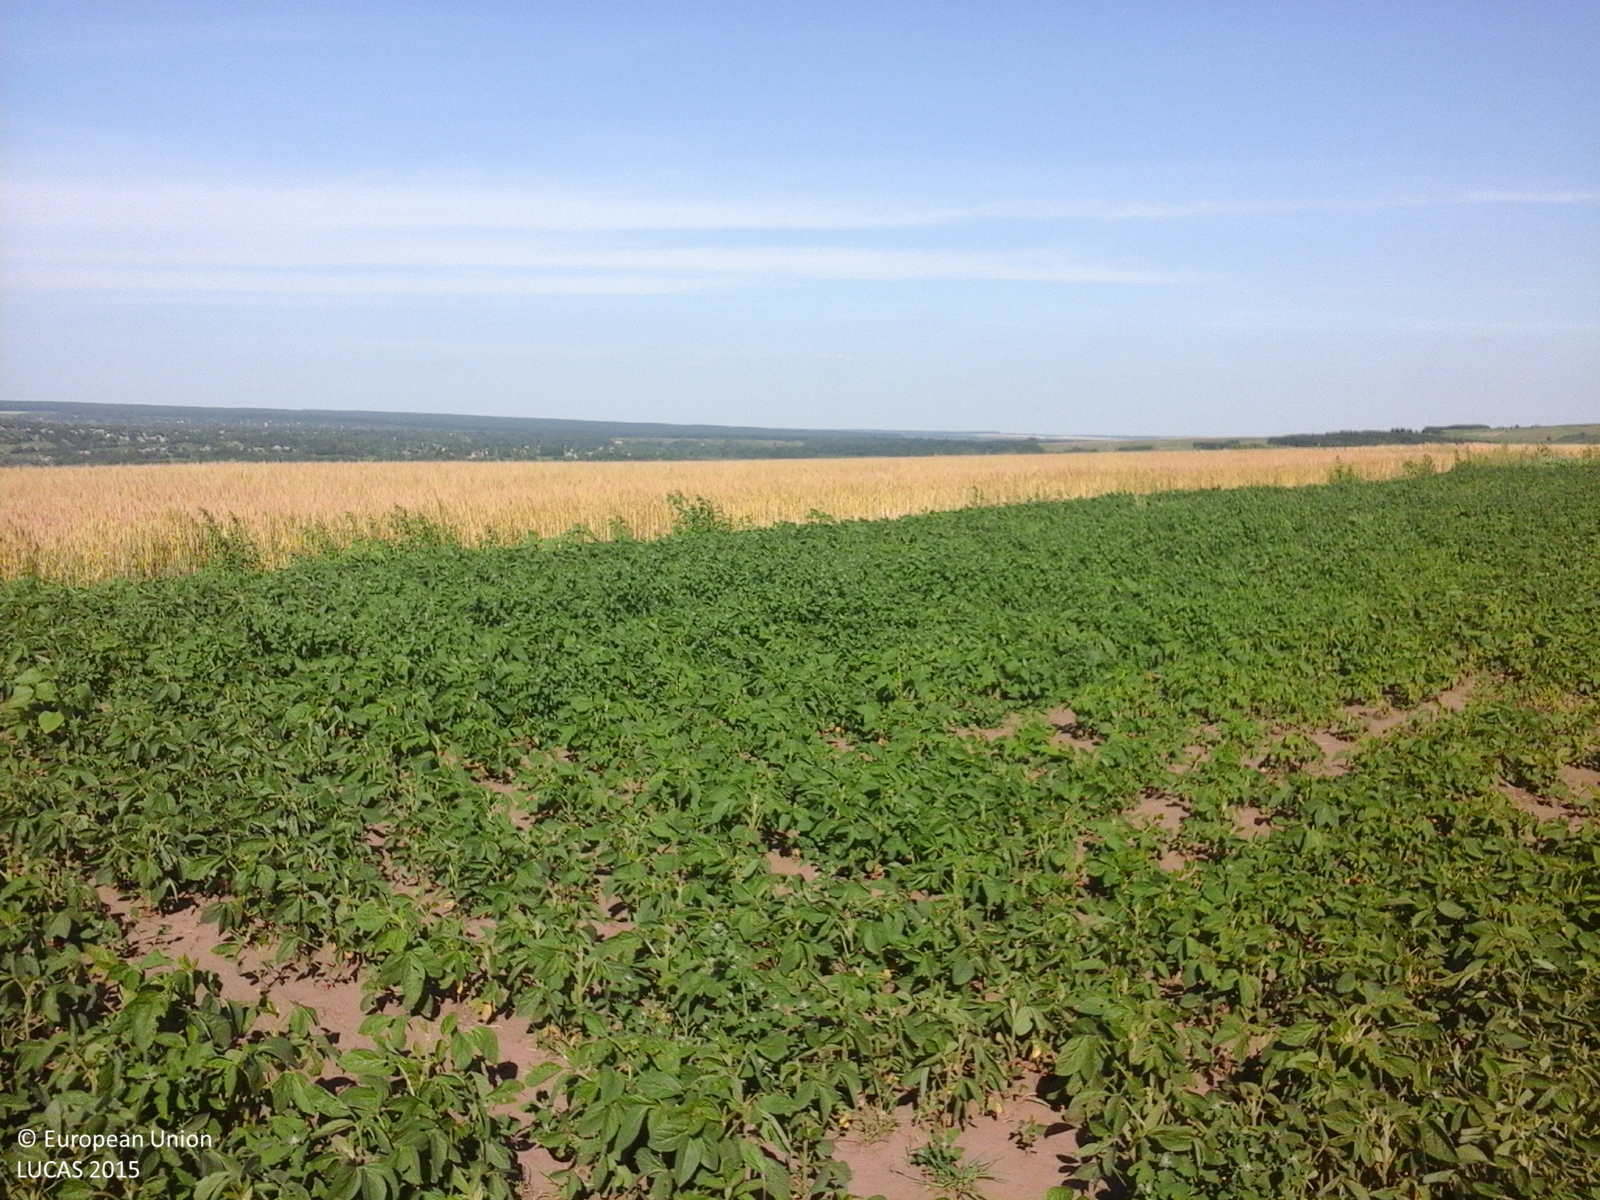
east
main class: Cropland
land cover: Common wheat
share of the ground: > 75 %
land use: Agriculture (excluding fallow land and kitchen gardens)
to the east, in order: Common wheat
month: June
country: RO
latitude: 48.2255
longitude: 26.8075
